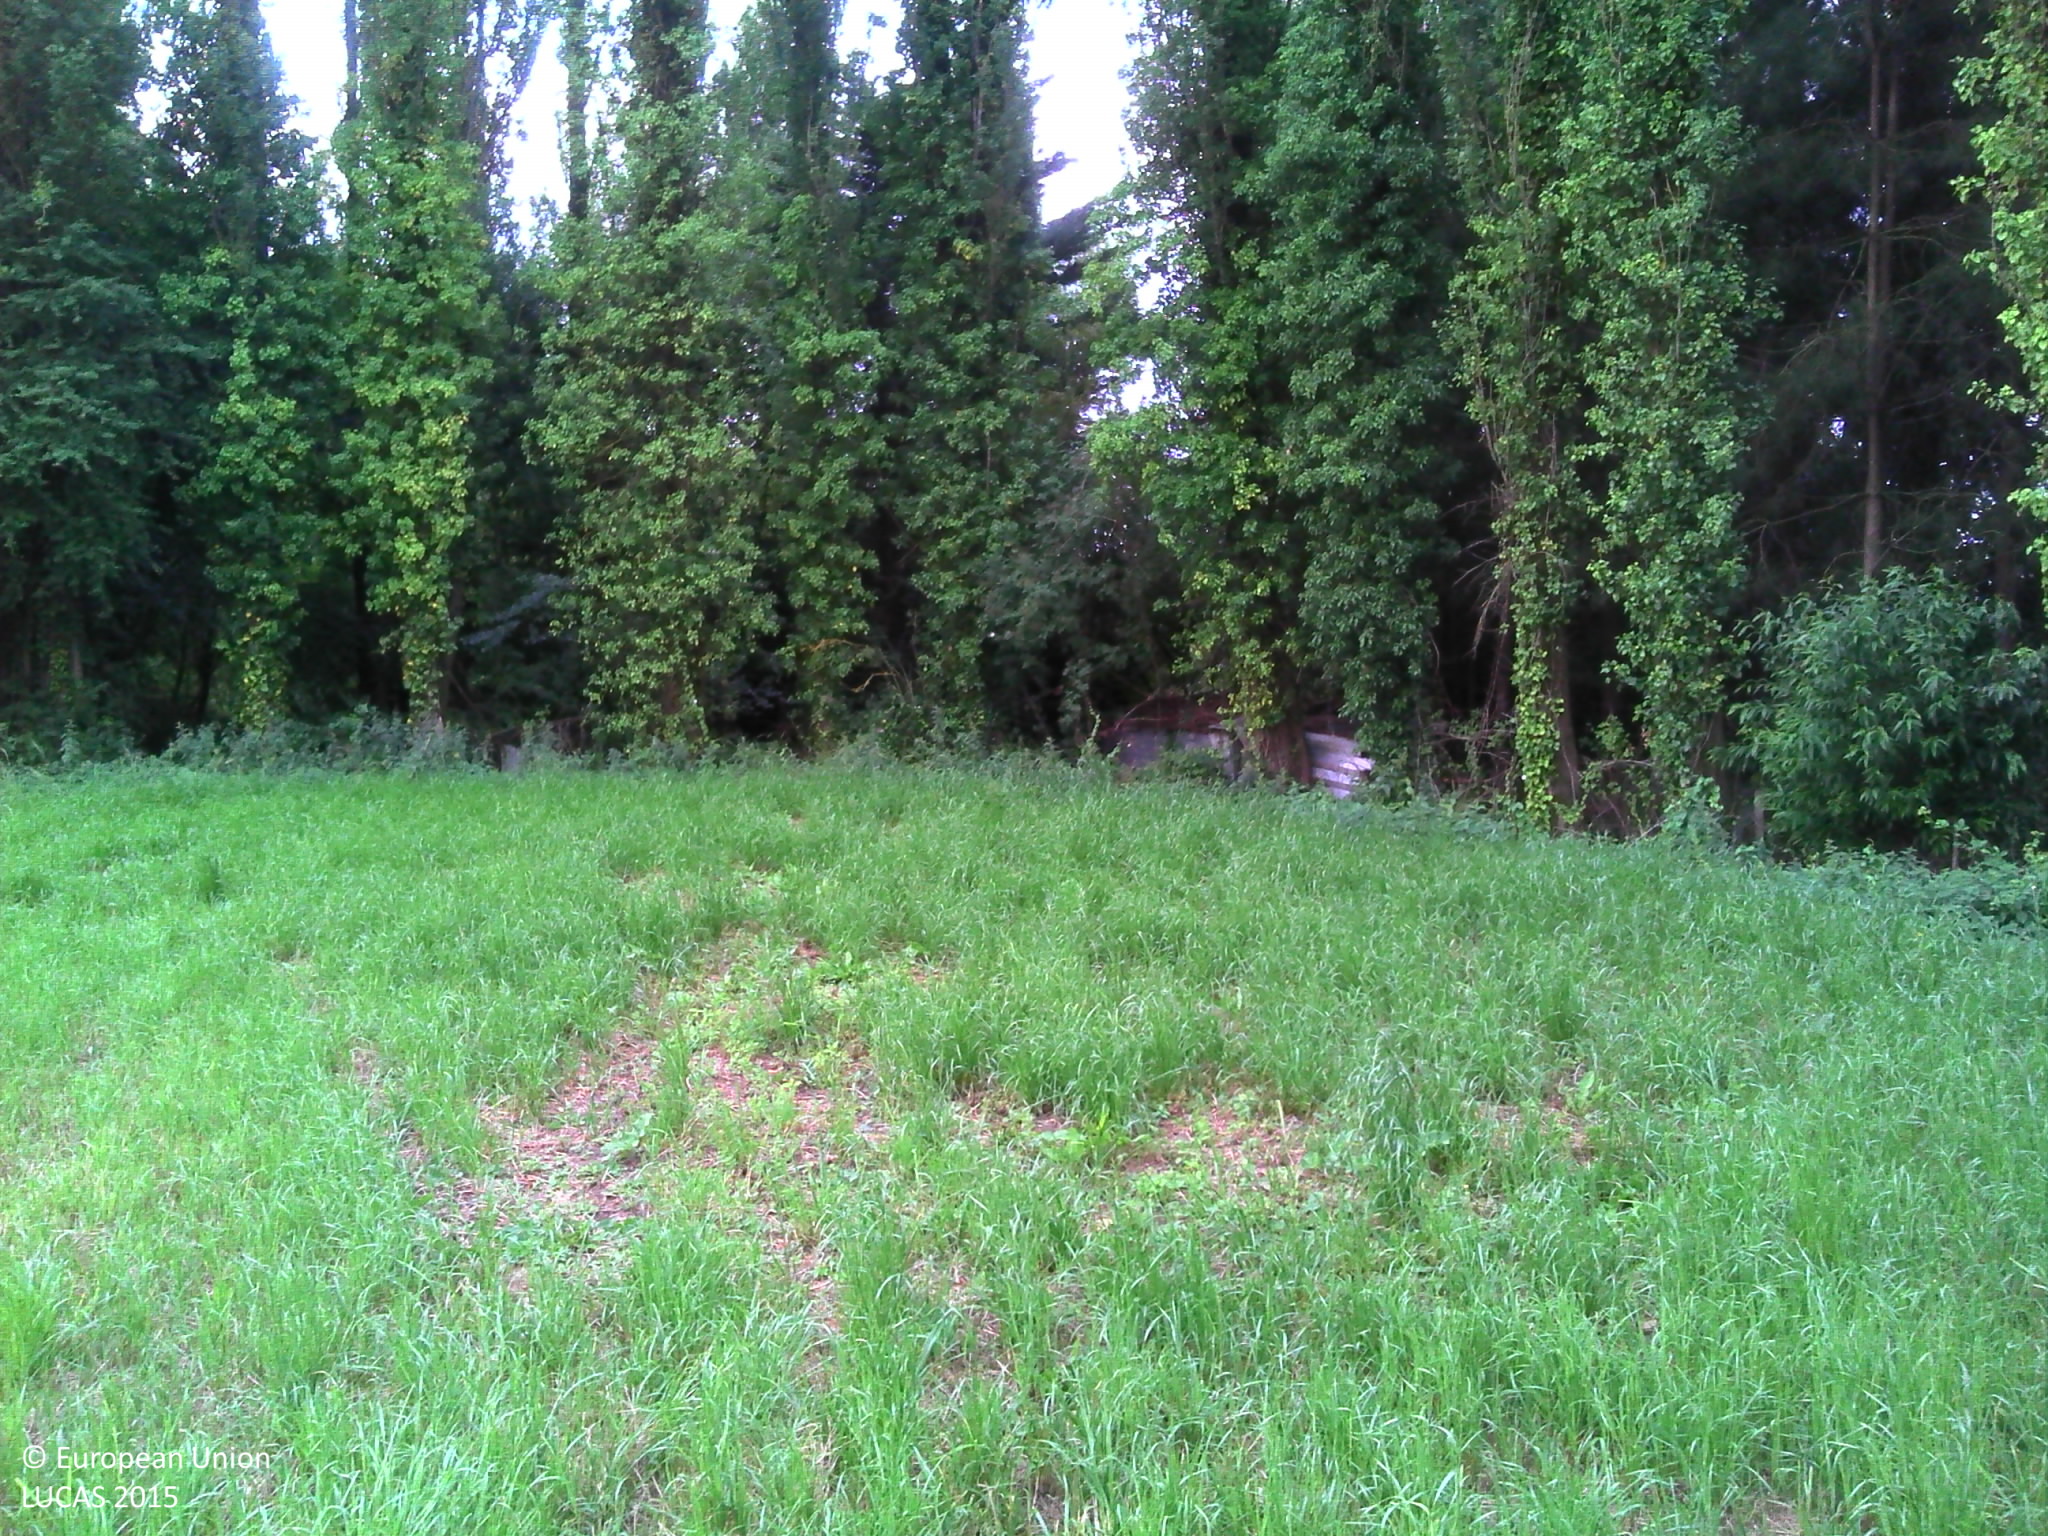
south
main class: Cropland
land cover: Temporary grasslands
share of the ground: > 75 %
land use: Agriculture (excluding fallow land and kitchen gardens)
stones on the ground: < 10 %
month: July
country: FR
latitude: 47.0036
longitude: -1.8156
